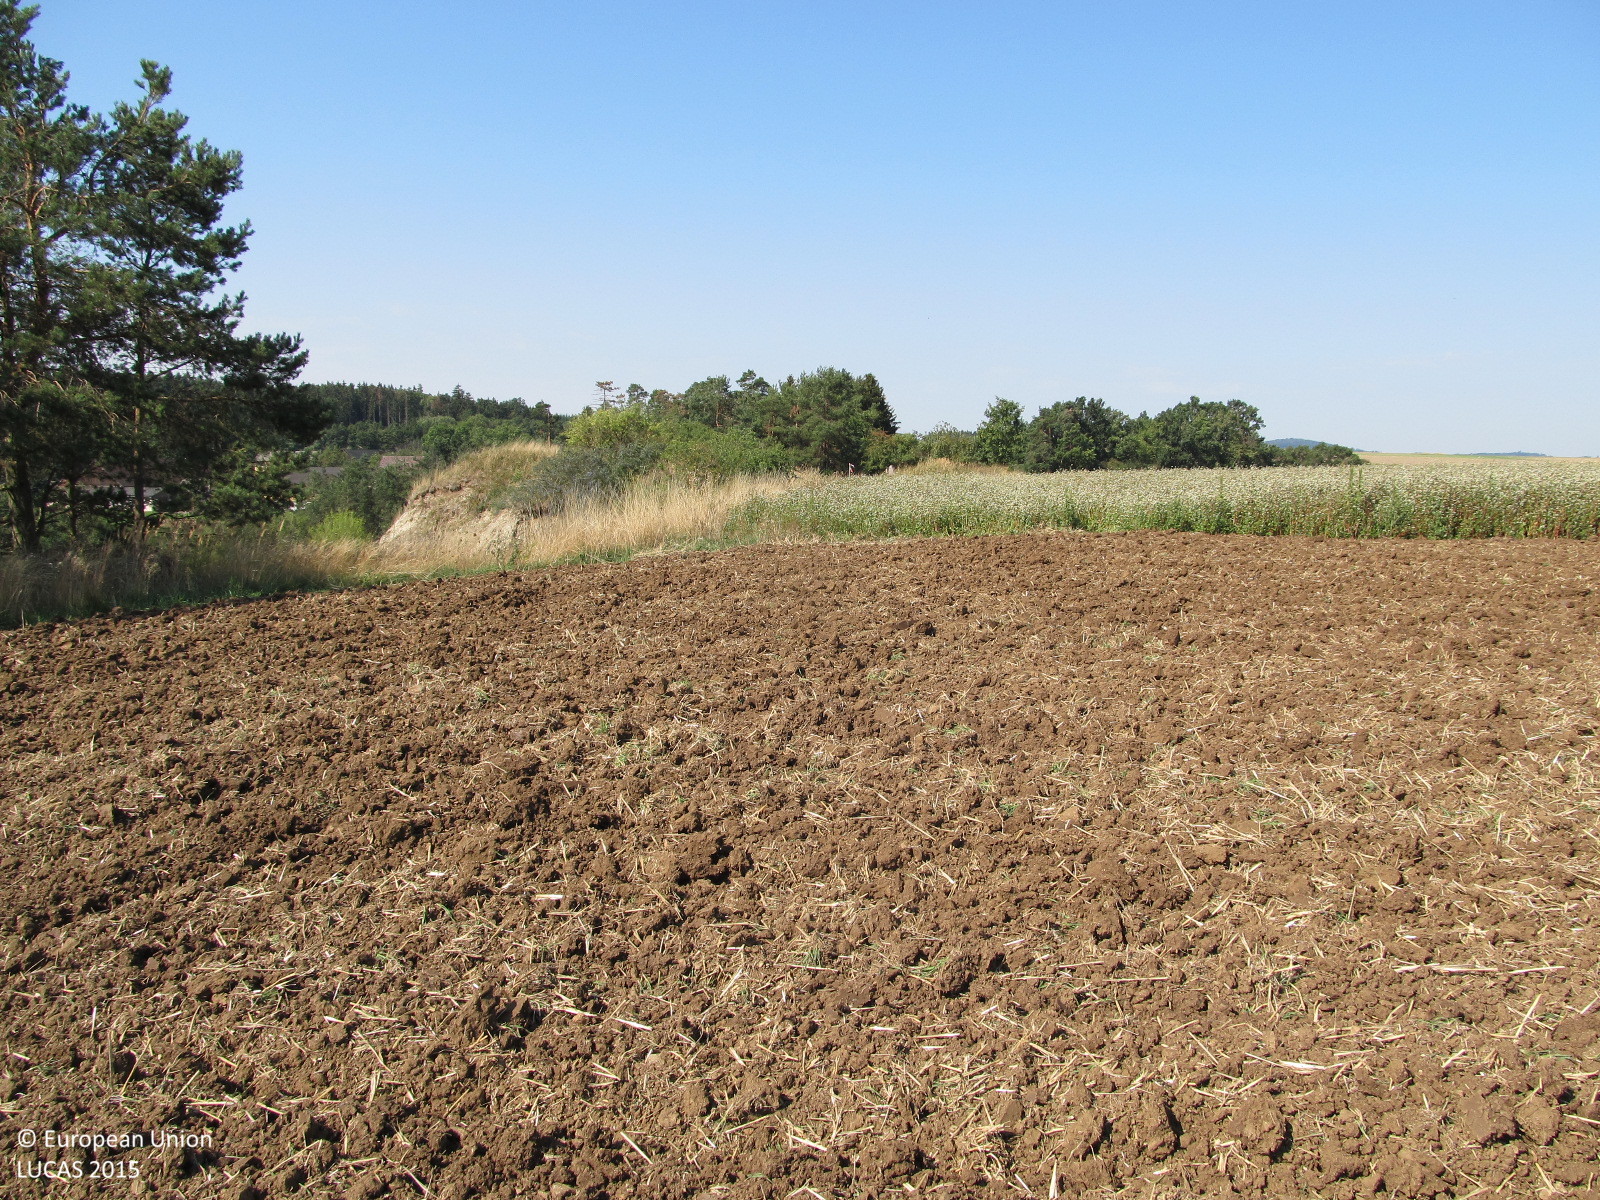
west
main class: Cropland
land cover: Common wheat
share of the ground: < 10 %
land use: Agriculture (excluding fallow land and kitchen gardens)
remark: Harvested field
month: September
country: AT
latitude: 48.8192
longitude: 15.6284
